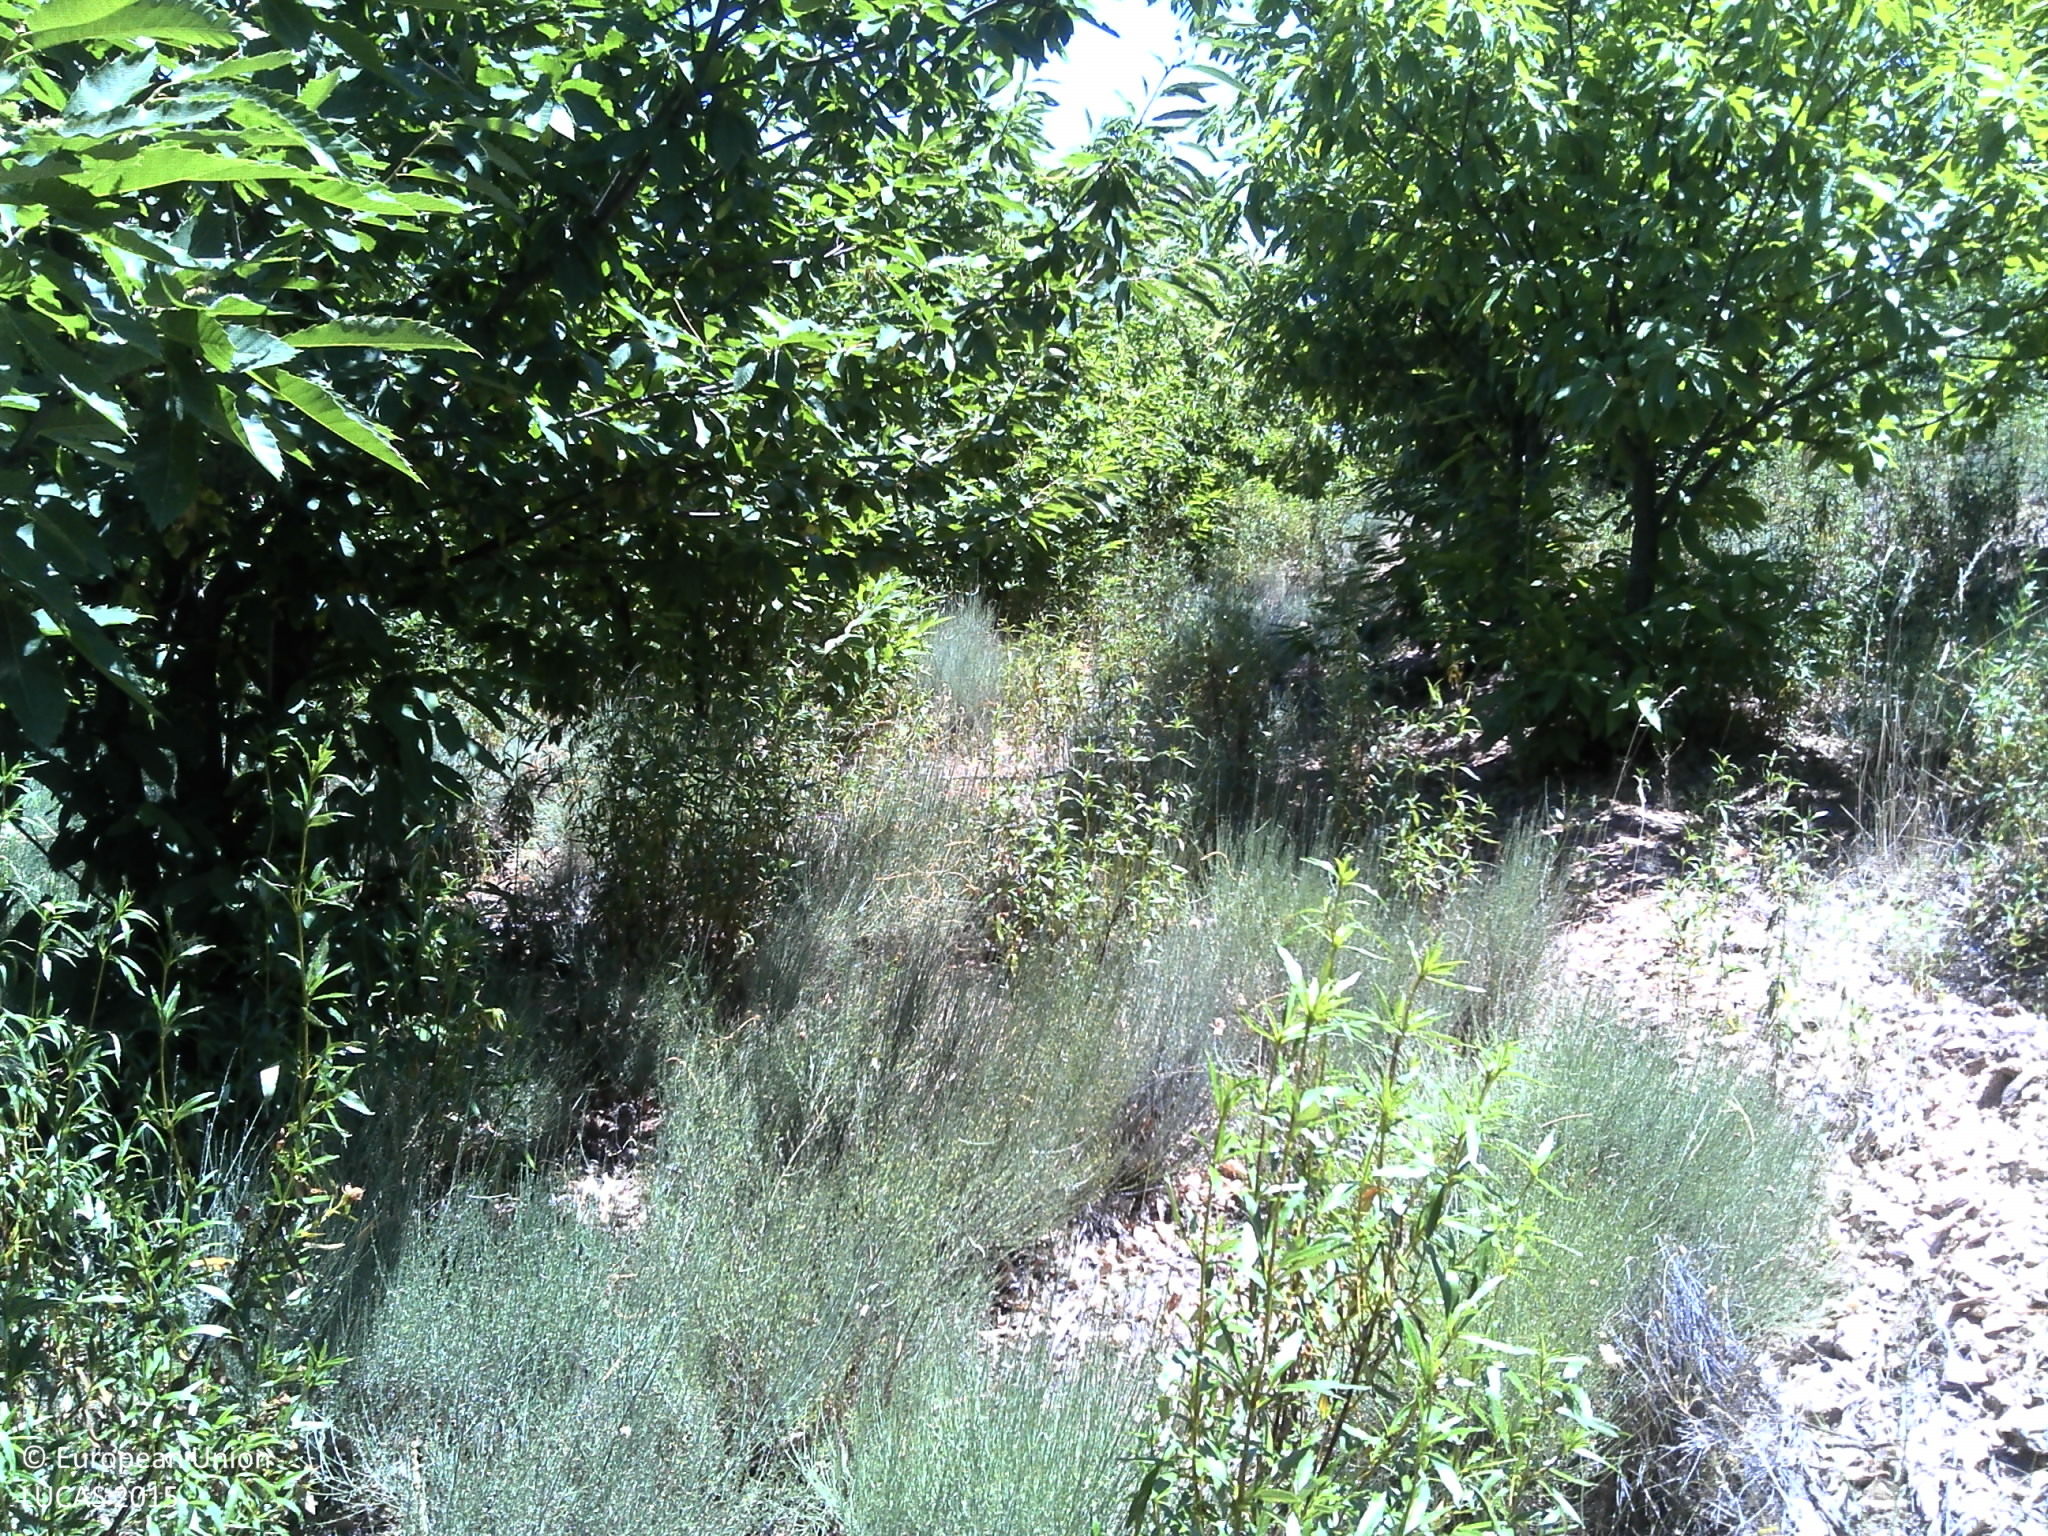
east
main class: Woodland
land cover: Broadleaved woodland
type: thermophilous deciduous forest
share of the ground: 10 - 25 %
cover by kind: shrubs 80 %, broadleaved forest trees 20 %
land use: Forestry
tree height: < 5 m
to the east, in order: Broadleaved woodland
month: June
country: PT
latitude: 41.0489
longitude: -6.9409
